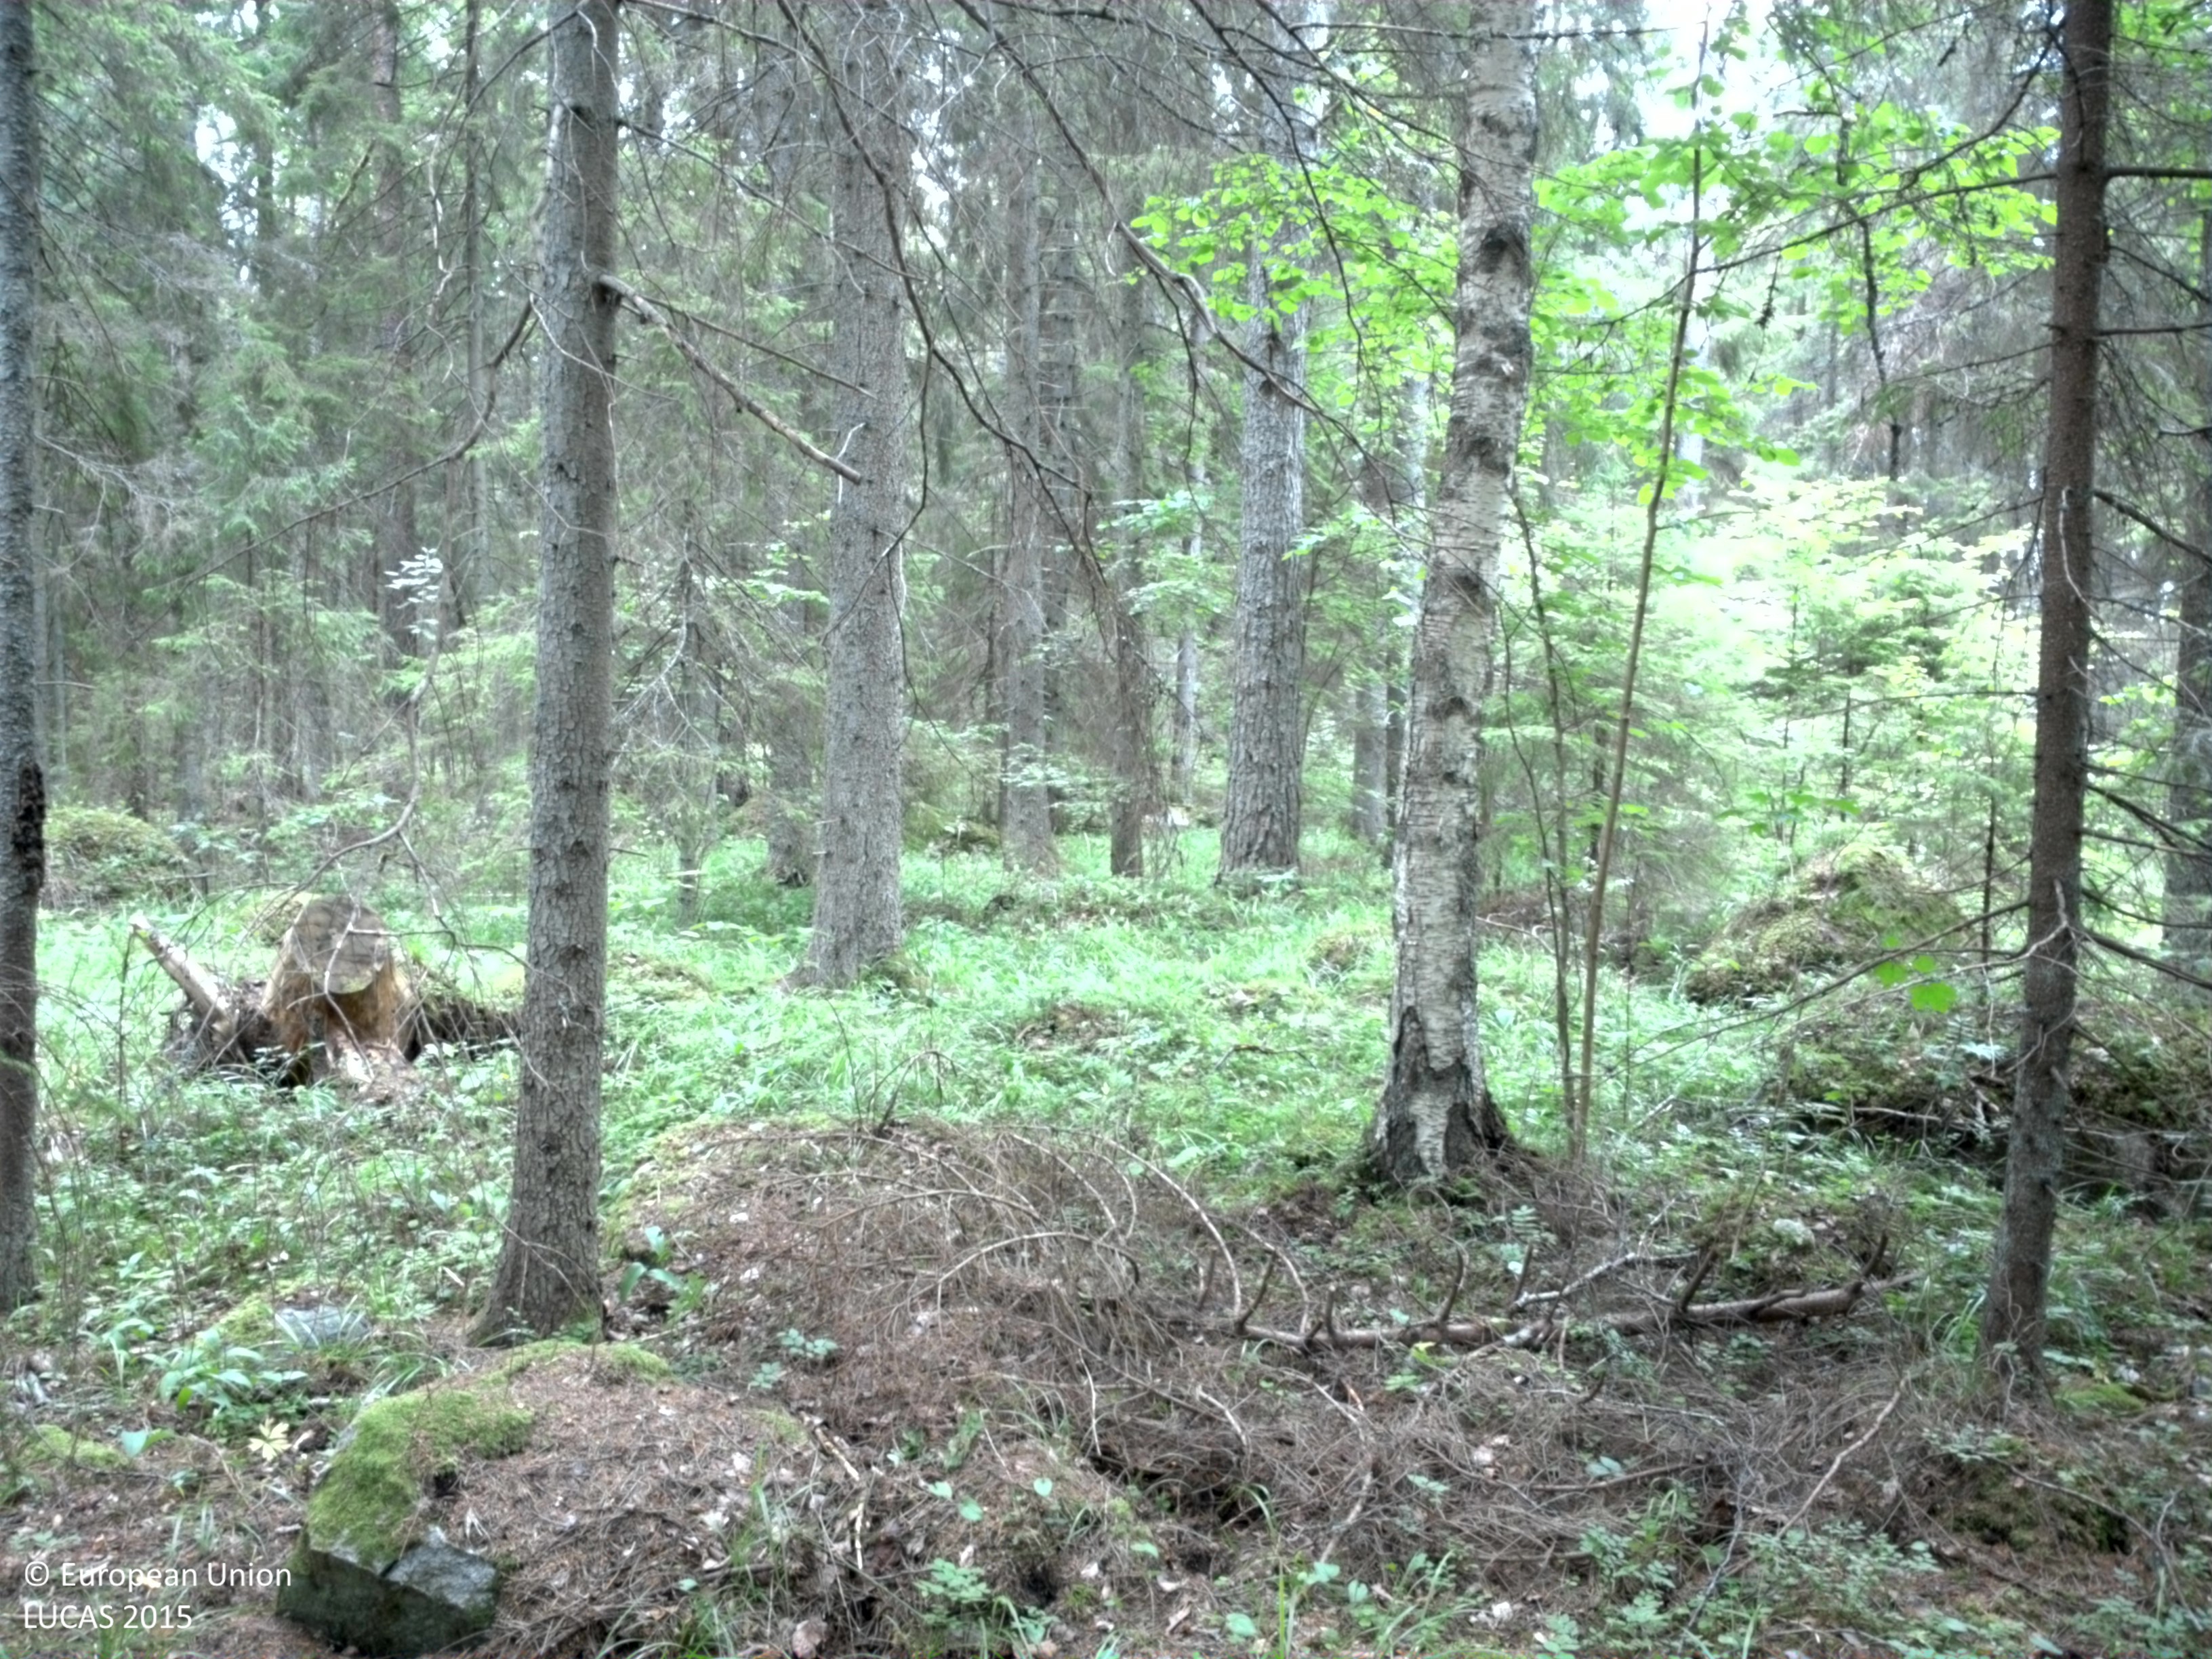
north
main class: Woodland
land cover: Spruce dominated coniferous woodland
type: boreal forest
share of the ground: > 75 %
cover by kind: coniferous forest trees 65 %, broadleaved forest trees 10 %, shrubs 10 %, herbaceous plants 10 %, lichens and mosses 5 %
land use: Forestry
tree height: > 5 m
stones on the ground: < 10 %
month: July
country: SE
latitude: 59.8328
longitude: 18.5083
